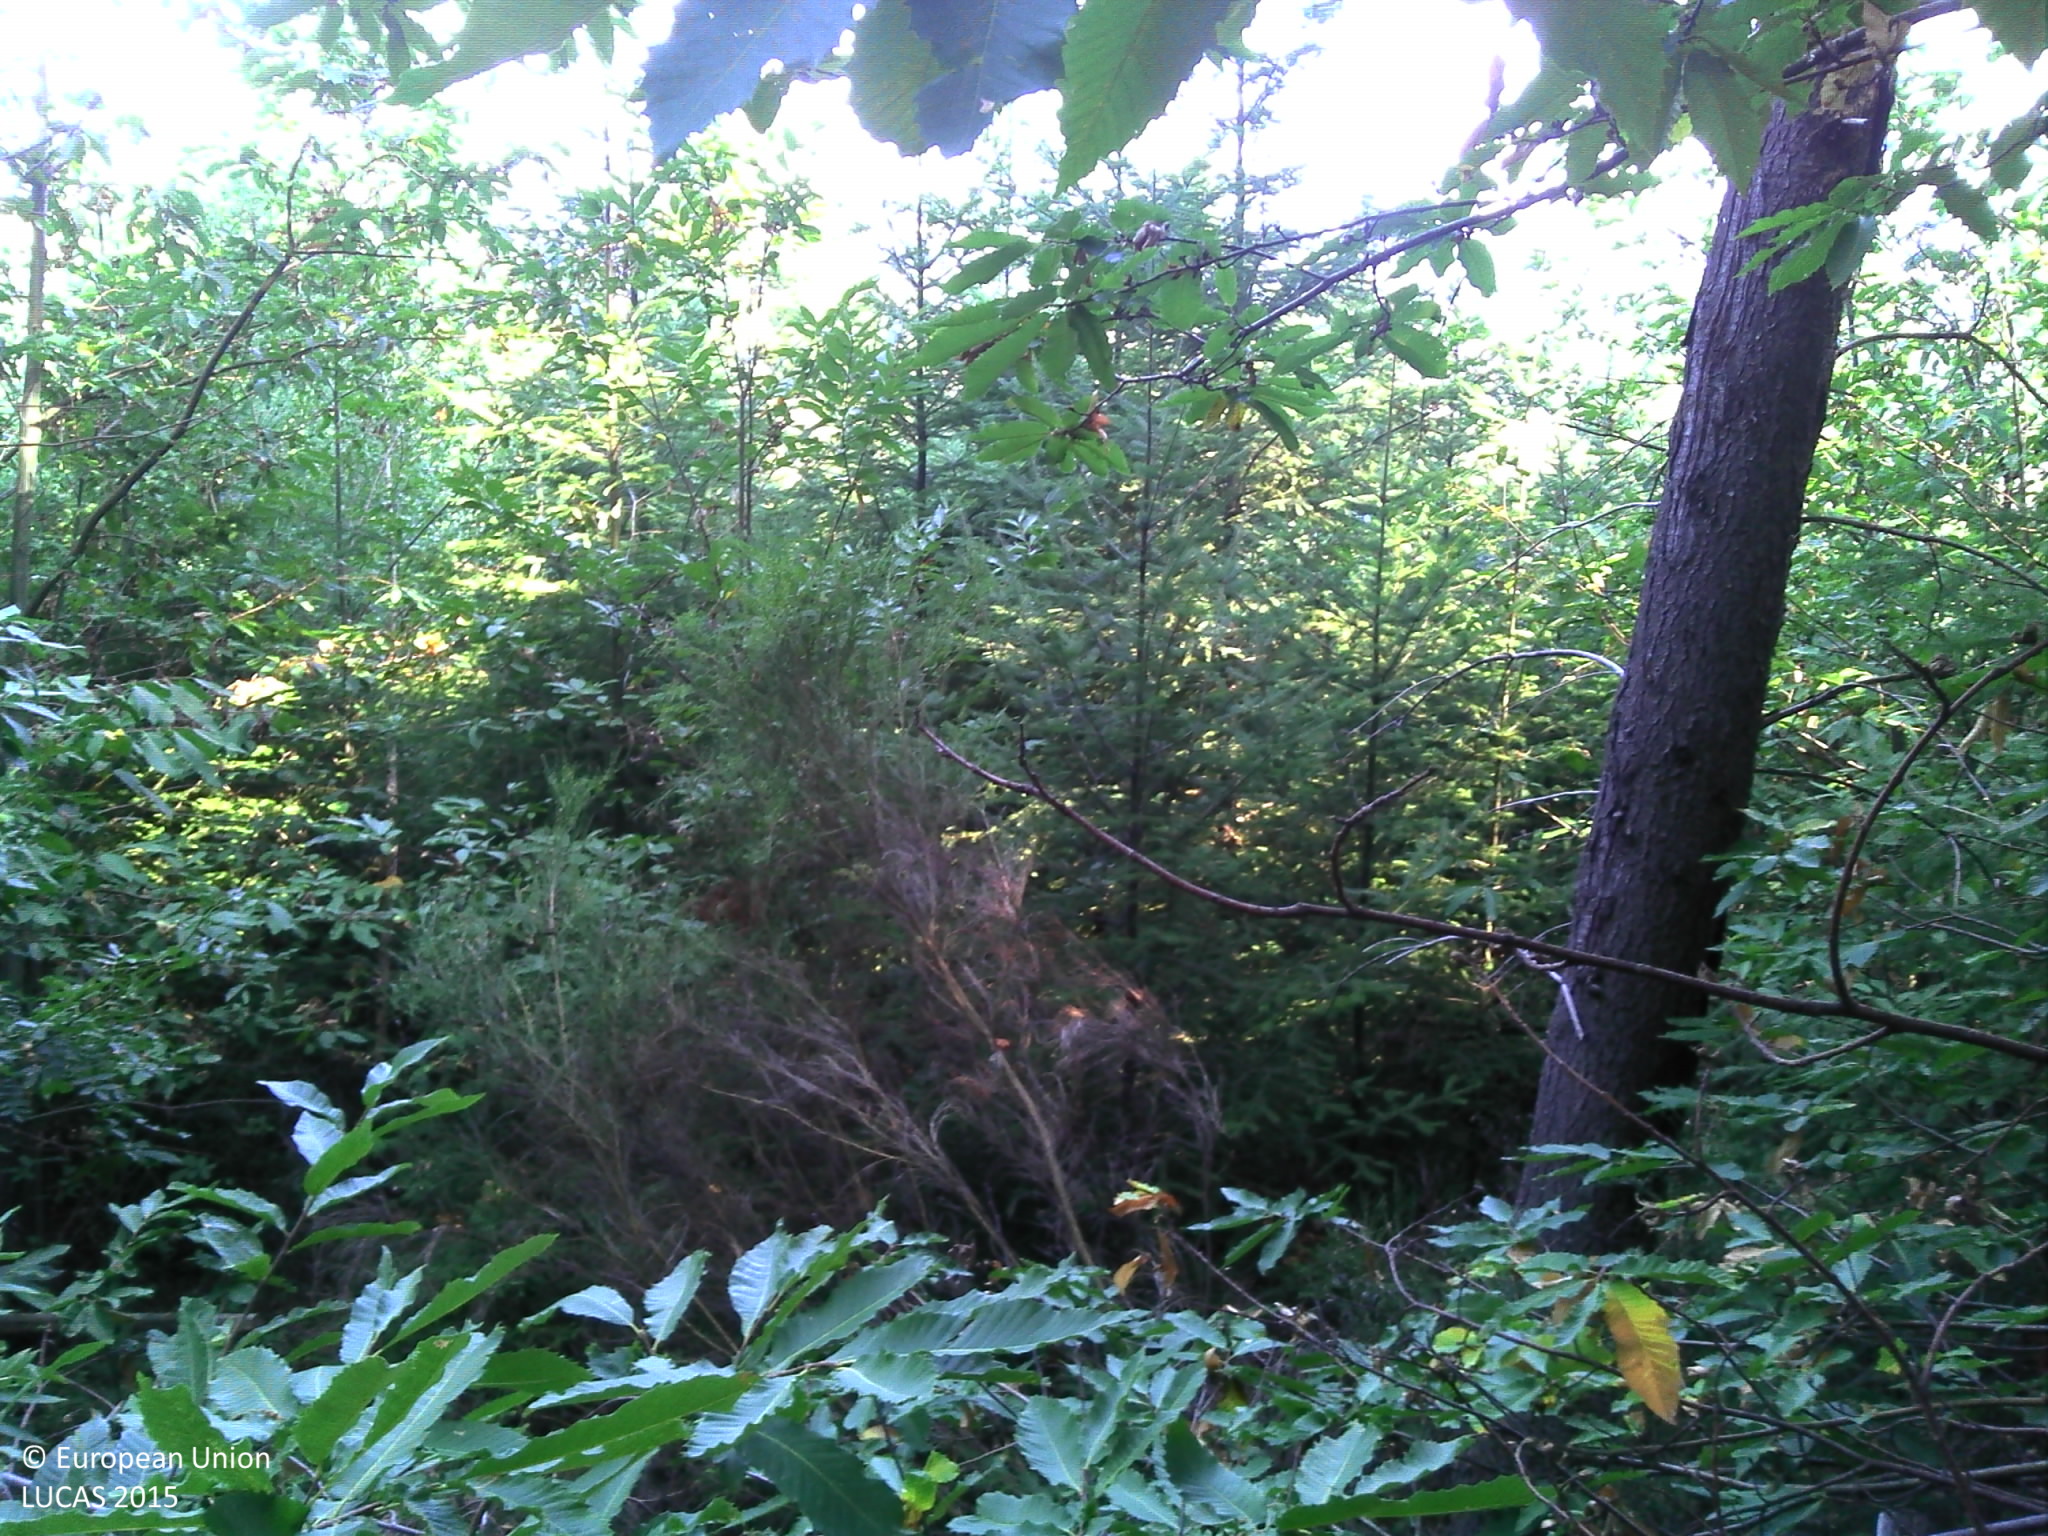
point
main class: Woodland
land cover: Spruce dominated mixed woodland
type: alpine coniferous forest
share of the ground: > 75 %
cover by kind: coniferous forest trees 50 %, broadleaved forest trees 25 %, herbaceous plants 25 %
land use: Forestry
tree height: > 5 m
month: August
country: FR
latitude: 45.0609
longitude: 4.6333
